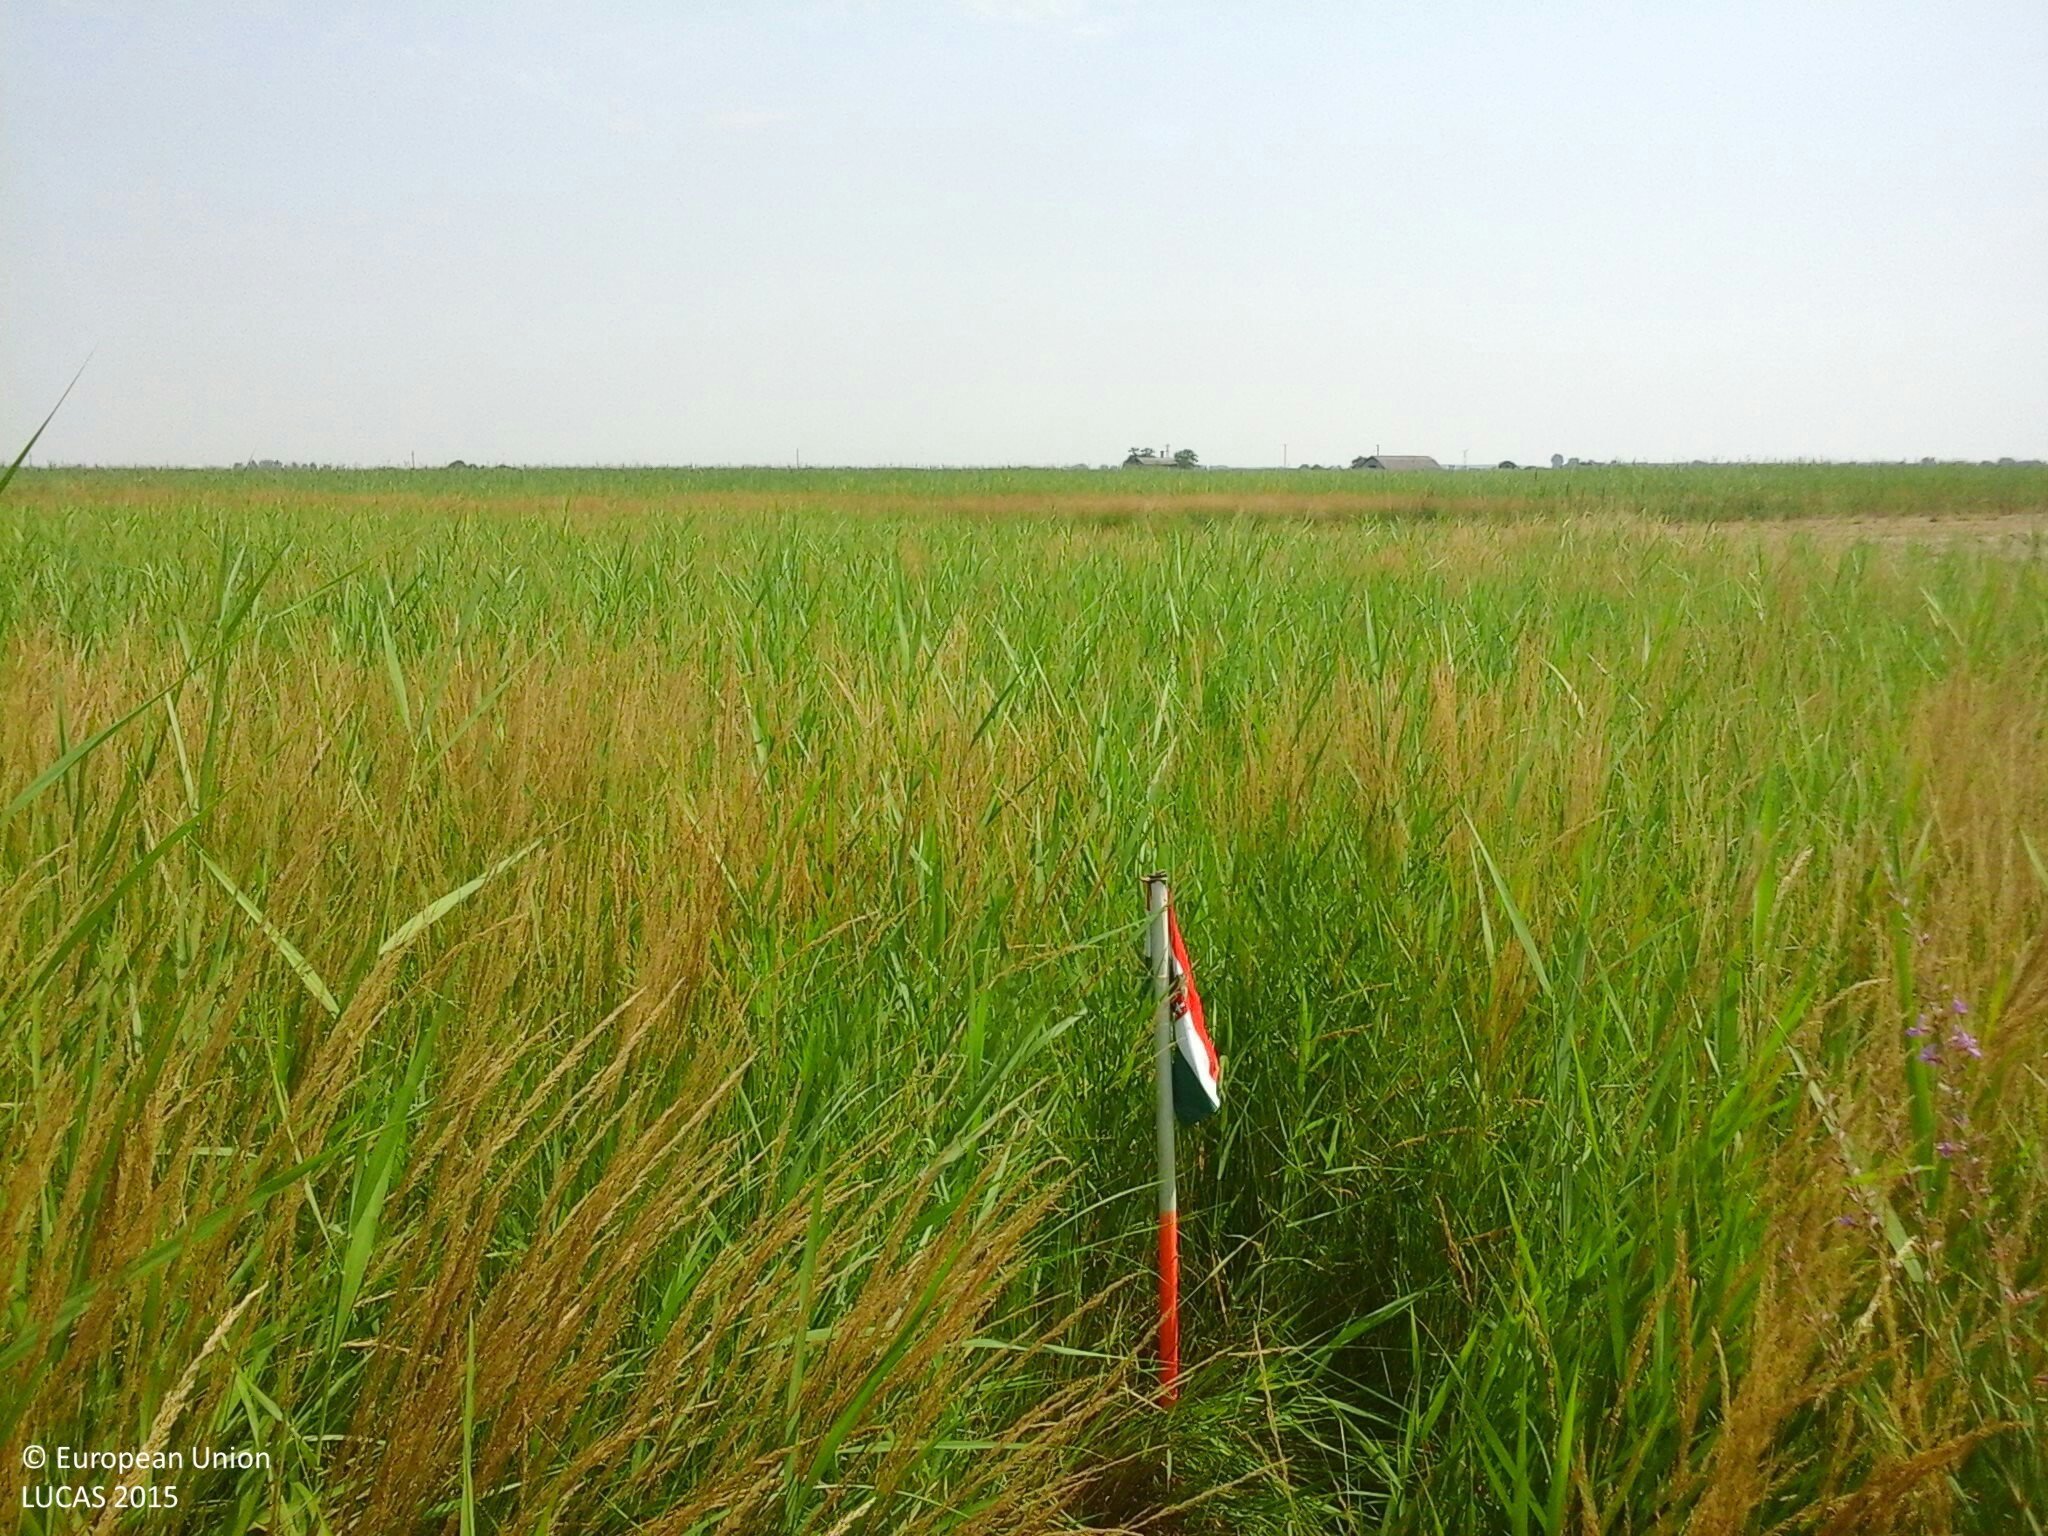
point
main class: Grassland
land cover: Grassland without tree/shrub cover
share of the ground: > 75 %
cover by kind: herbaceous plants 100 %
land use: Agriculture (excluding fallow land and kitchen gardens)
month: July
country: HU
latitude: 46.8434
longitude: 20.1875
